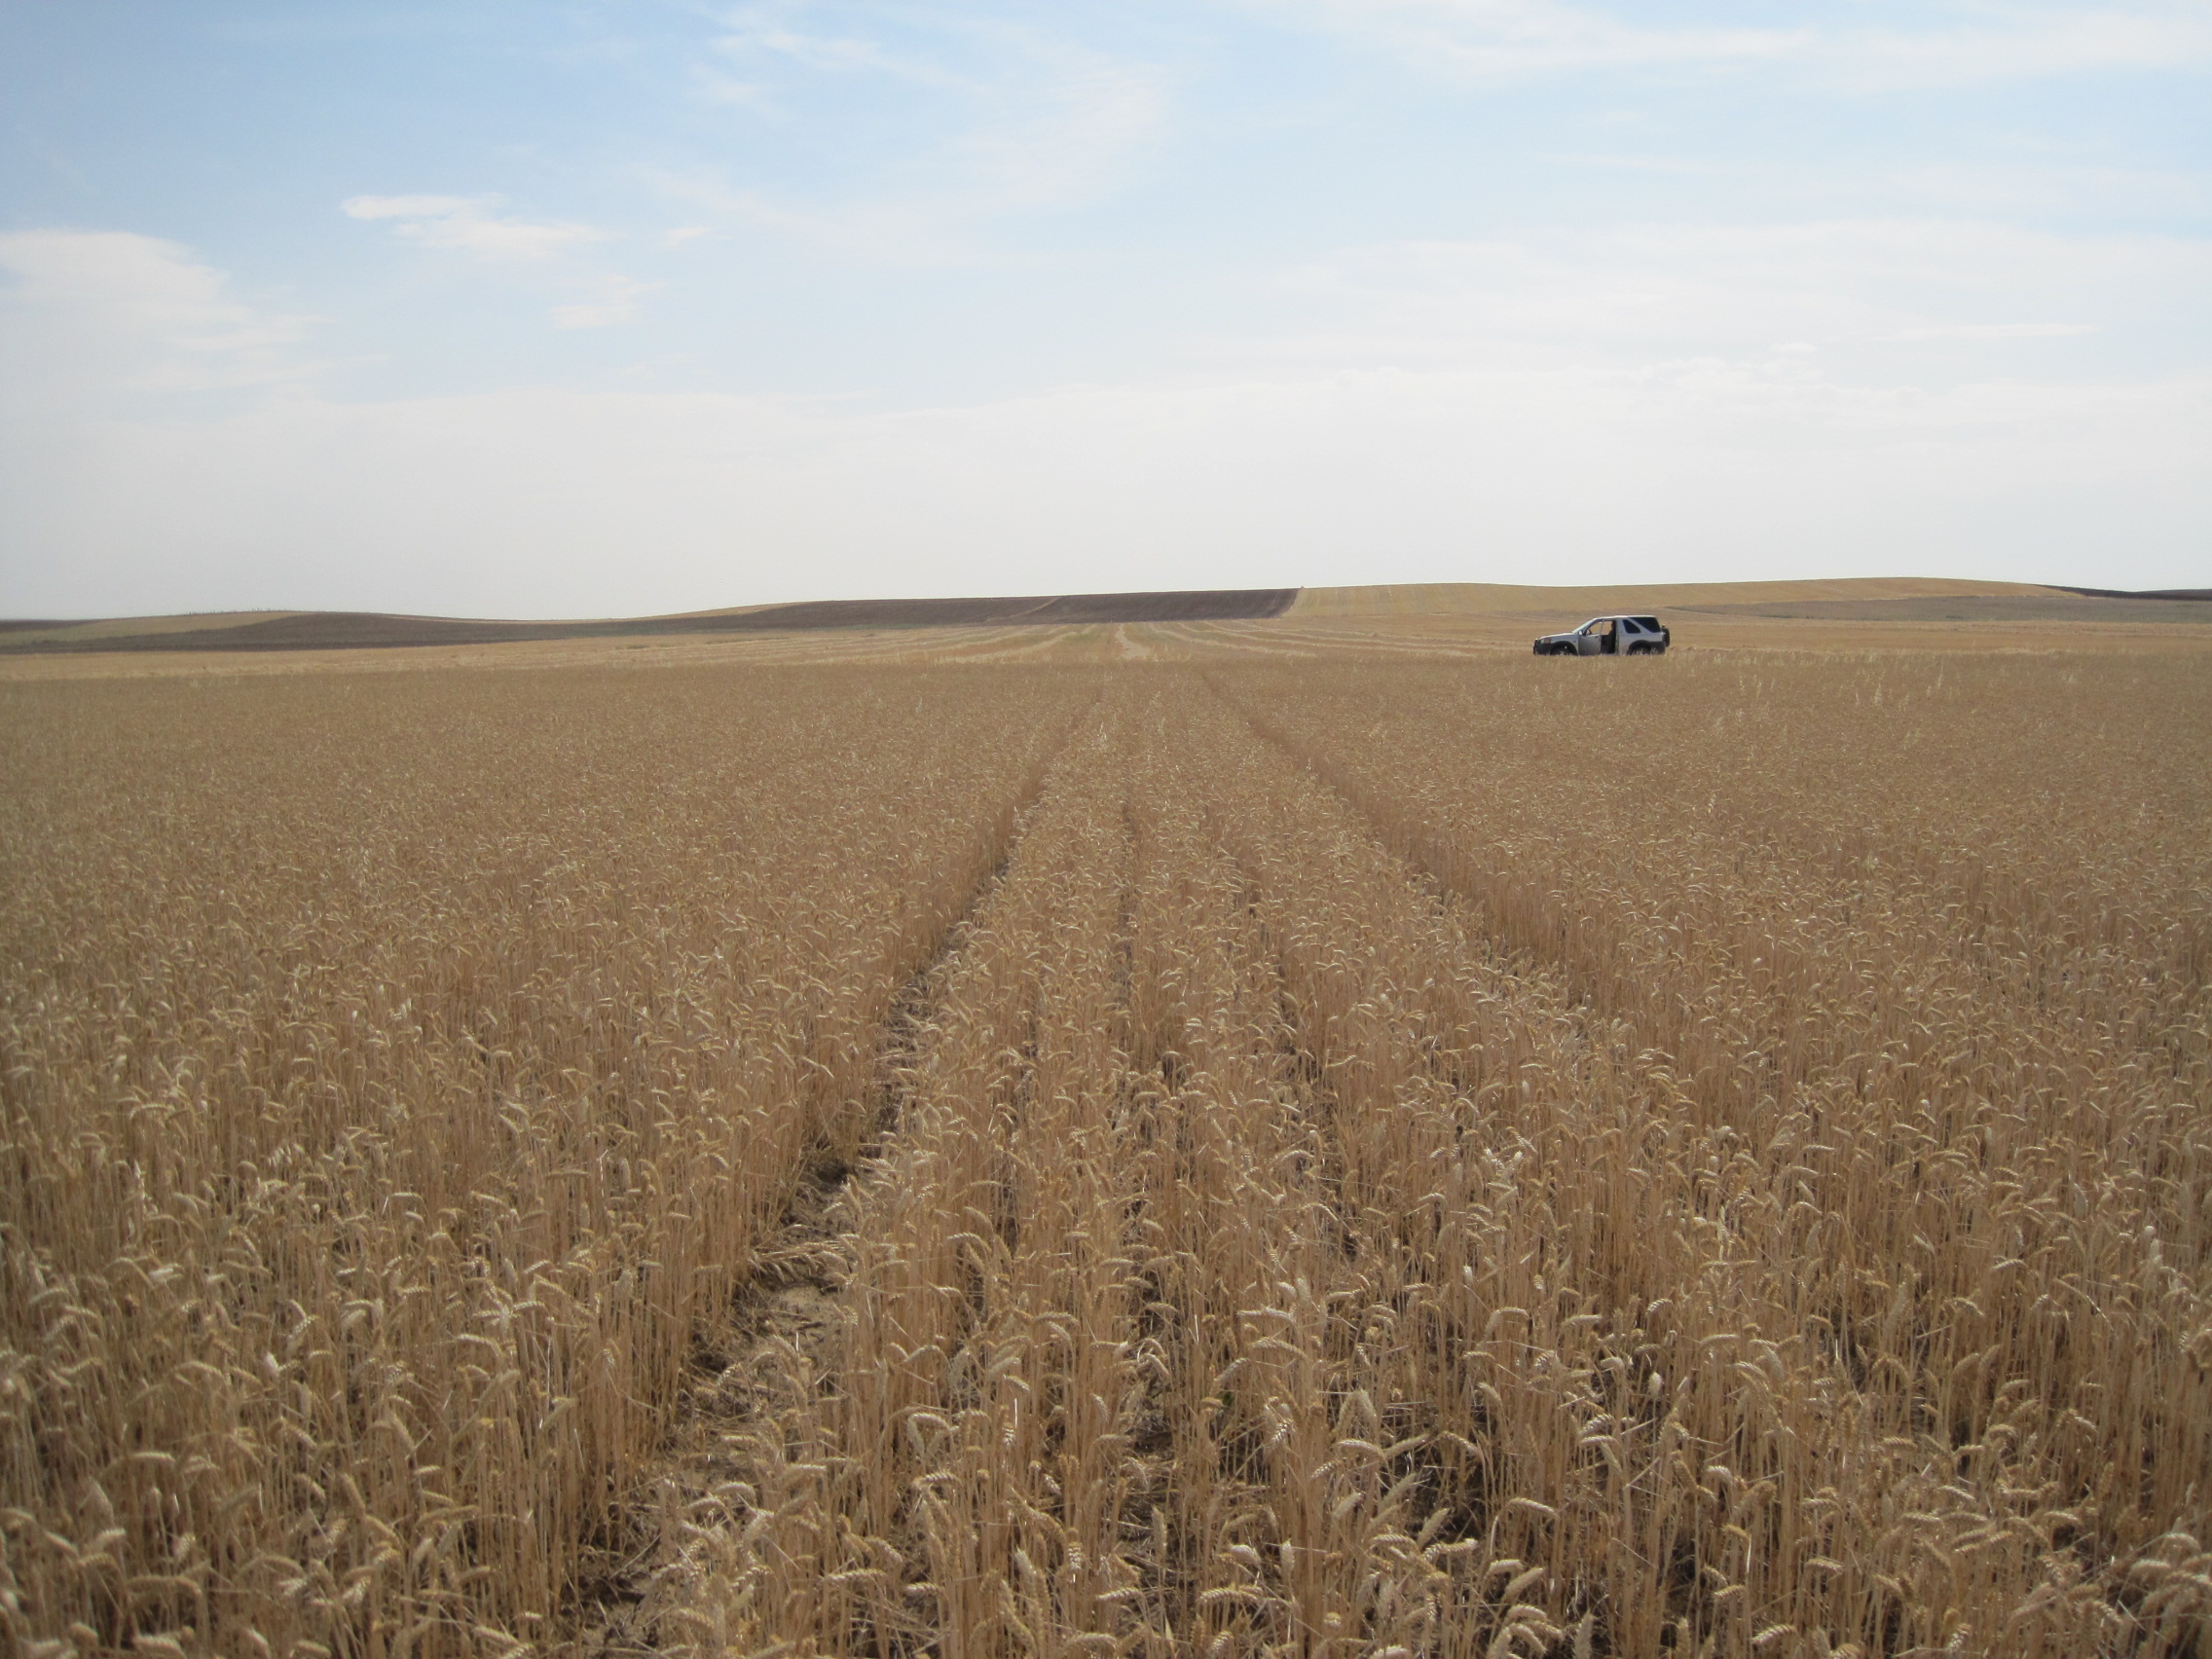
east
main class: Cropland
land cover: Common wheat
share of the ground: > 75 %
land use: Agriculture (excluding fallow land and kitchen gardens)
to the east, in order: Common wheat; Grass margins; Common wheat
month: July
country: ES
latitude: 41.6949
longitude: -5.4756
